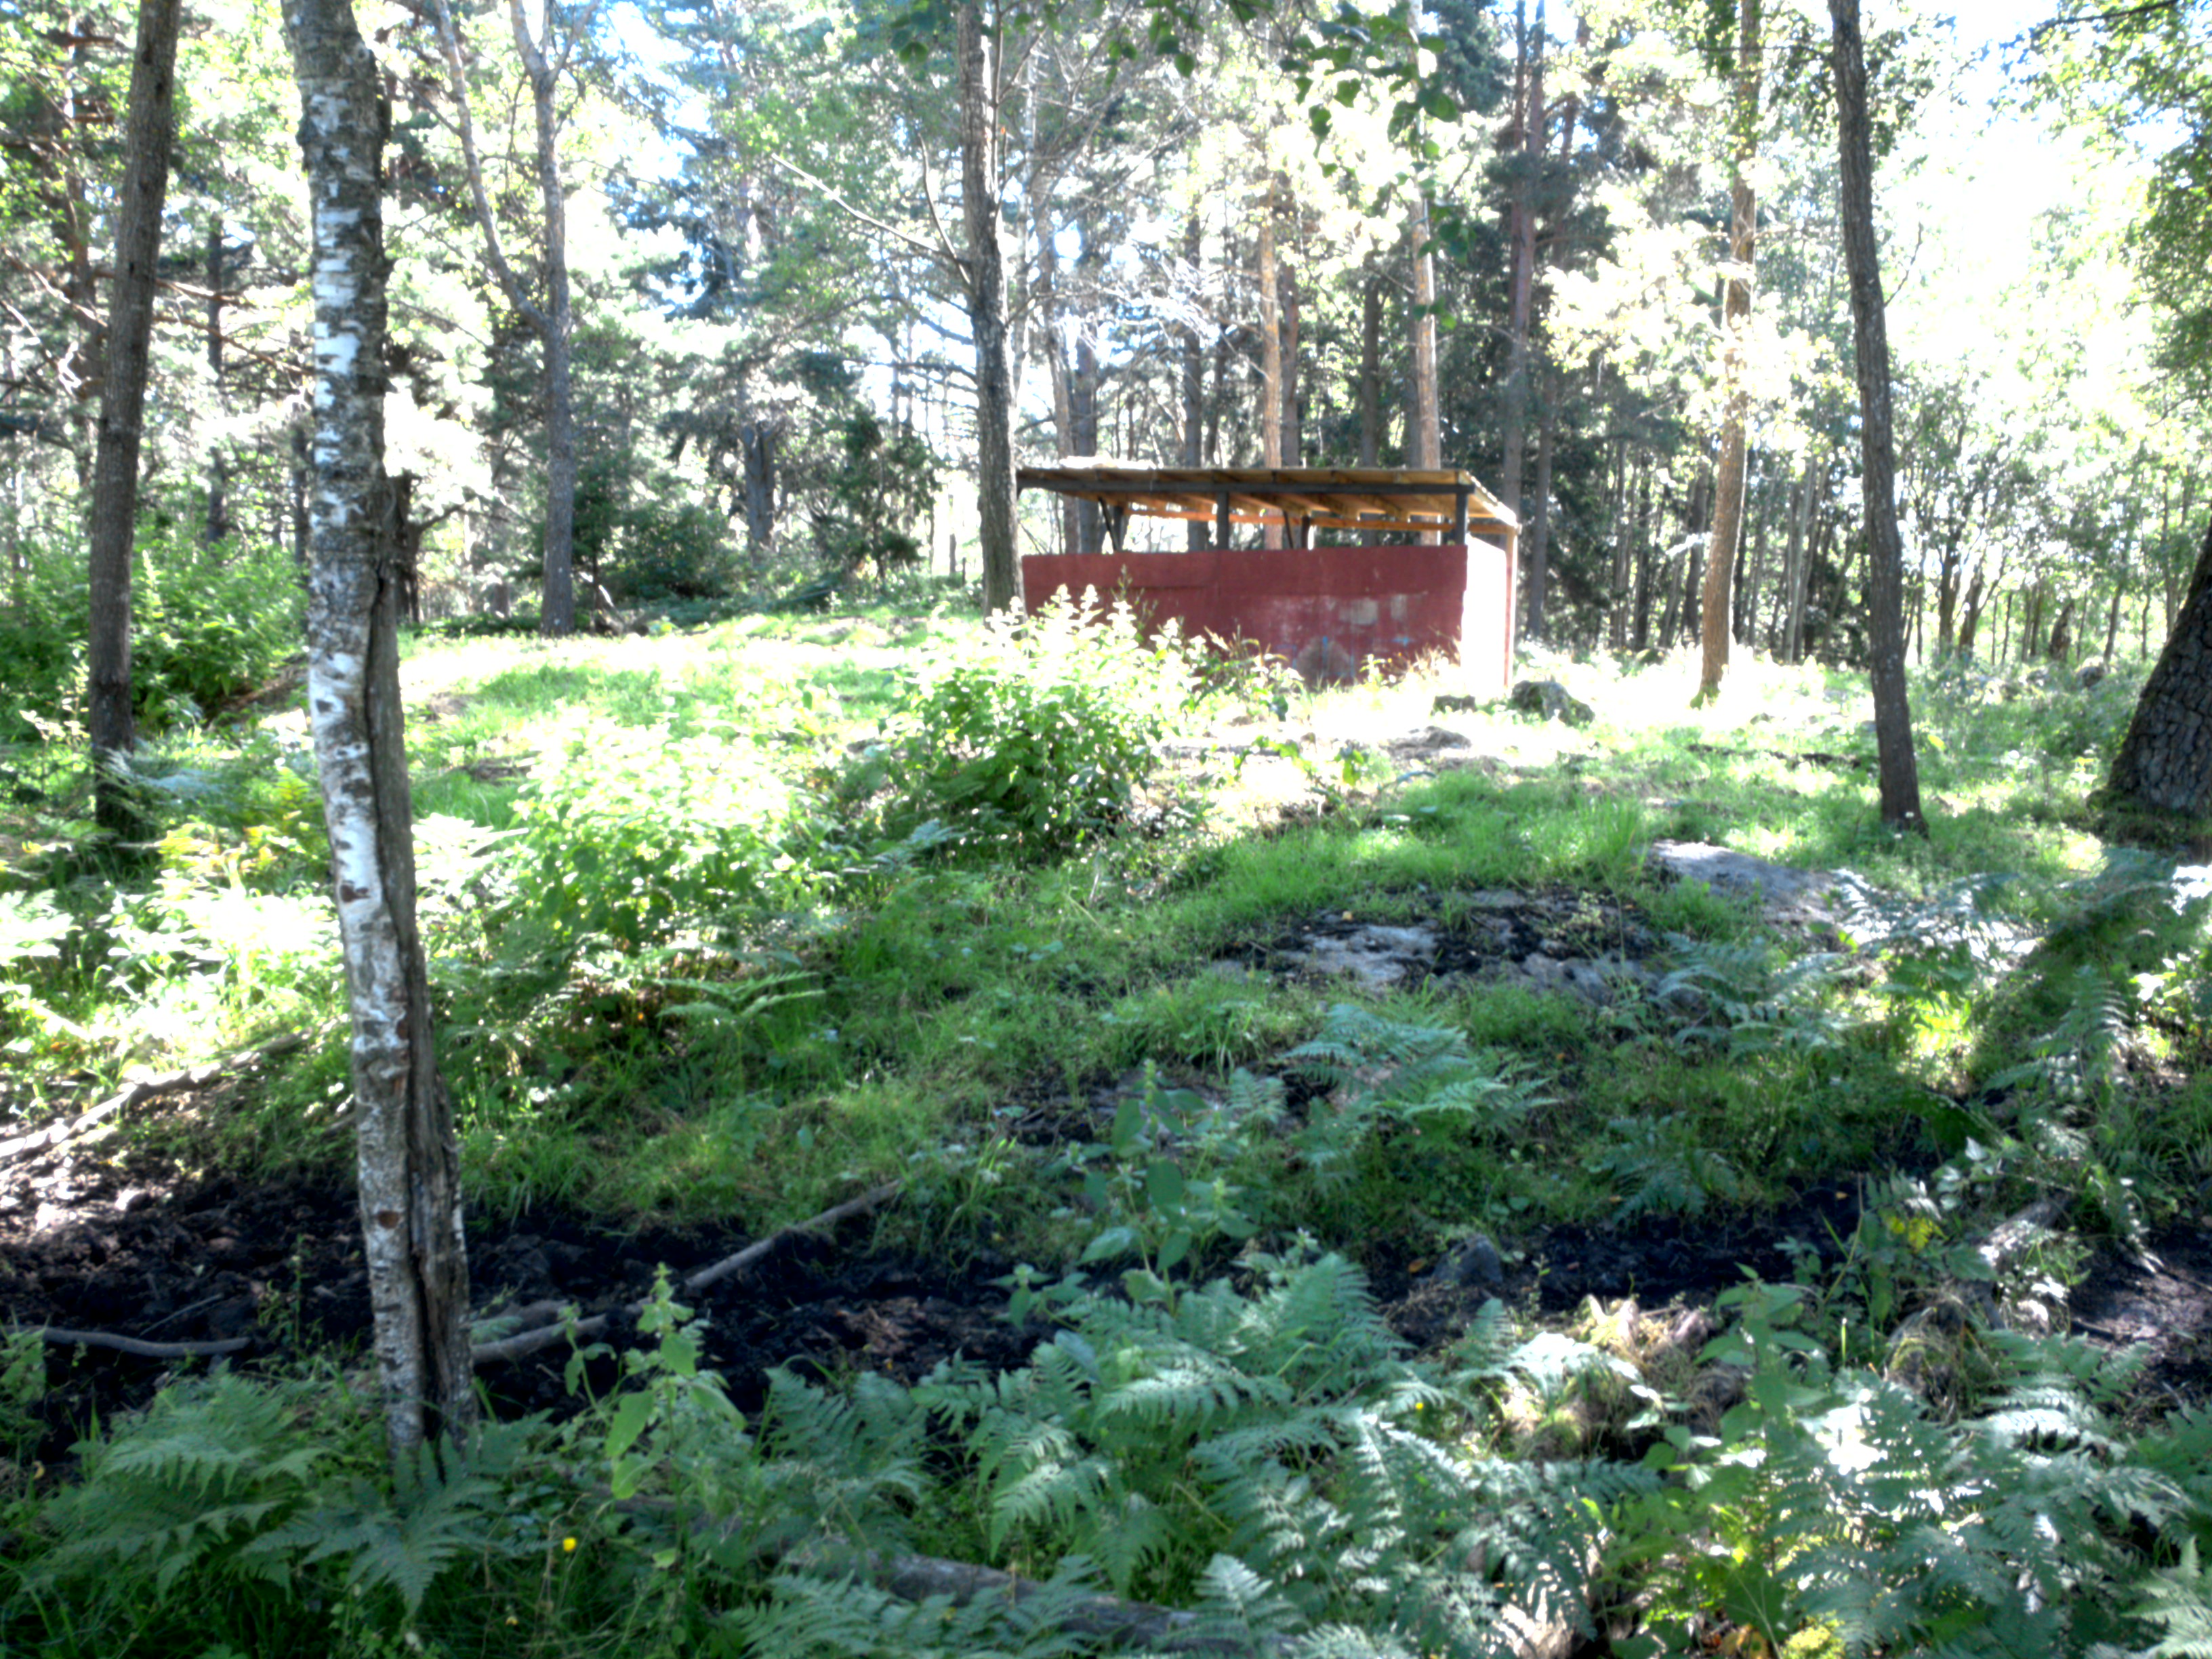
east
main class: Woodland
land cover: Broadleaved woodland
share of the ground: 50 - 75 %
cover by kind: herbaceous plants 50 %, broadleaved forest trees 40 %, coniferous forest trees 10 %
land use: Agriculture (excluding fallow land and kitchen gardens)
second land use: Forestry
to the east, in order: Broadleaved woodland; Fences; Pine dominated coniferous woodland; Broadleaved woodland; Pine dominated coniferous woodland; Ditches and canals; Paved roads, cycling and walking lanes; Pine dominated coniferous woodland; Fences; Pine dominated coniferous woodland; Grassland without tree/shrub cover
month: August
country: SE
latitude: 59.1714
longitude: 17.7479
